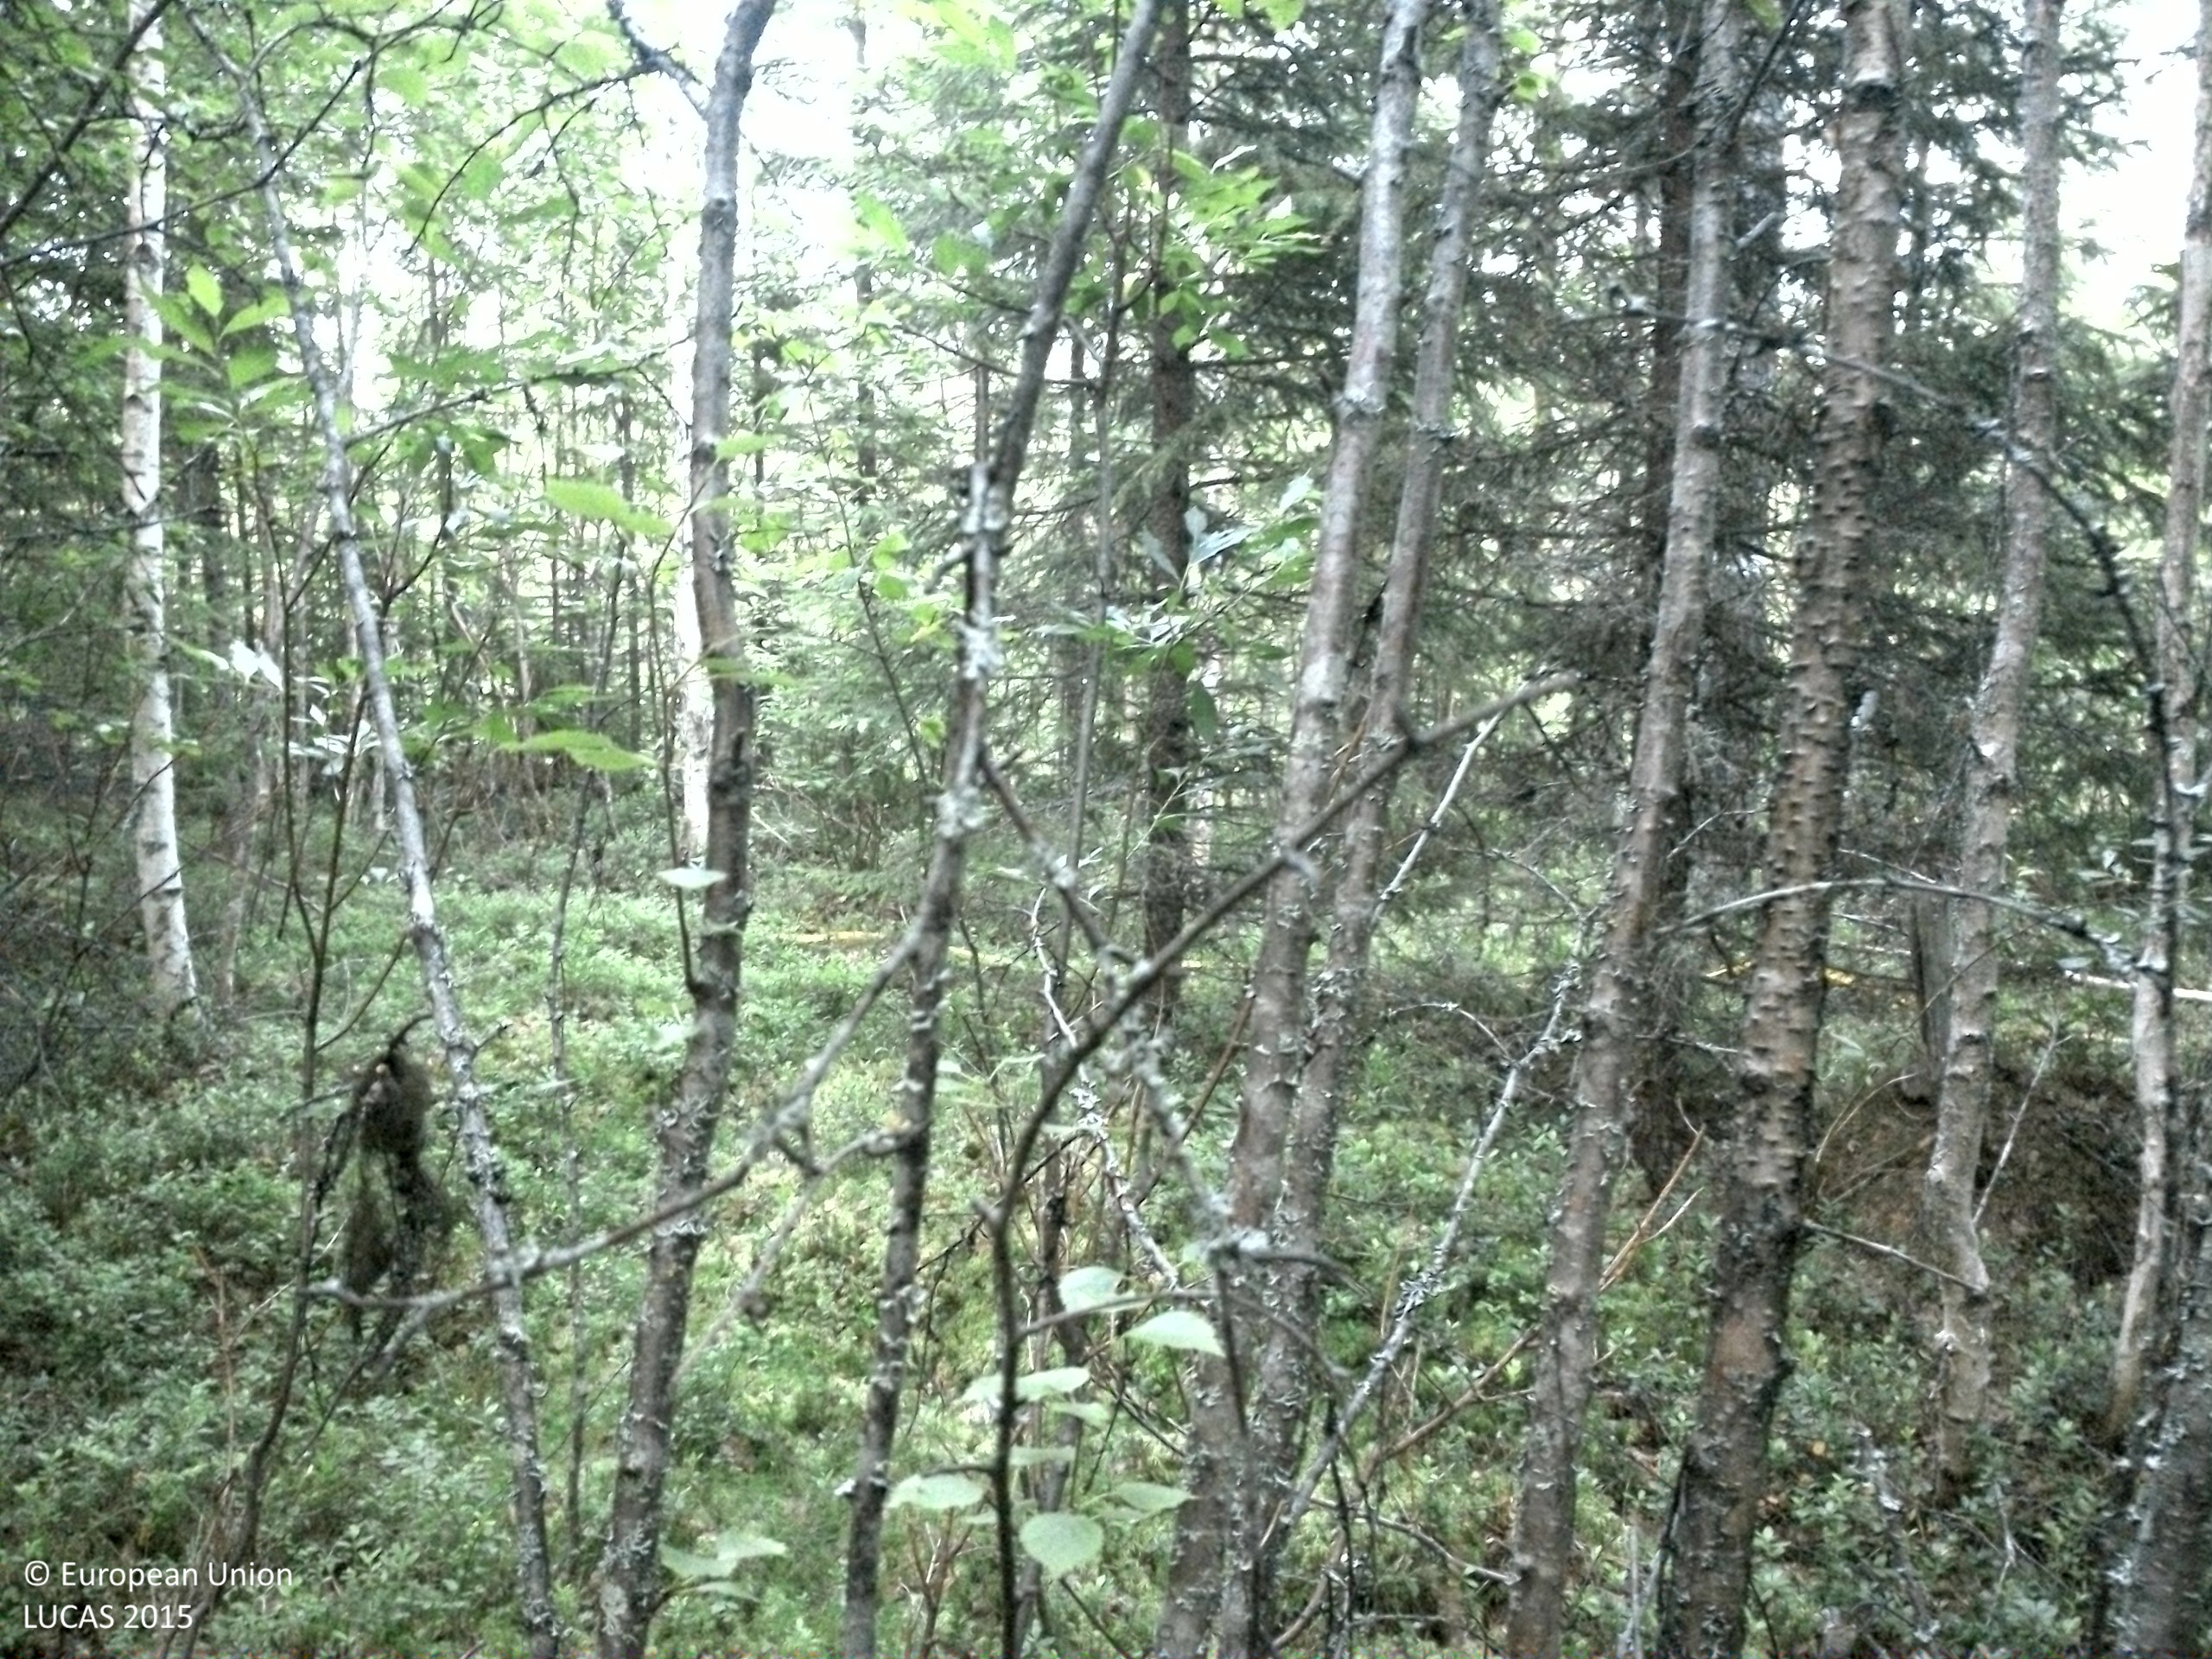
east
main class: Woodland
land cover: Other mixed woodland
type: boreal forest
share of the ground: > 75 %
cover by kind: broadleaved forest trees 50 %, coniferous forest trees 30 %, shrubs 10 %, lichens and mosses 10 %
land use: Forestry
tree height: > 5 m
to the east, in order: Other mixed woodland; Pine dominated mixed woodland; Spruce dominated mixed woodland; Rivers and streams; Spruce dominated mixed woodland; Pine dominated mixed woodland; Spruce dominated mixed woodland; Pine dominated coniferous woodland
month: August
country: SE
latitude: 63.6328
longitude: 16.4513
